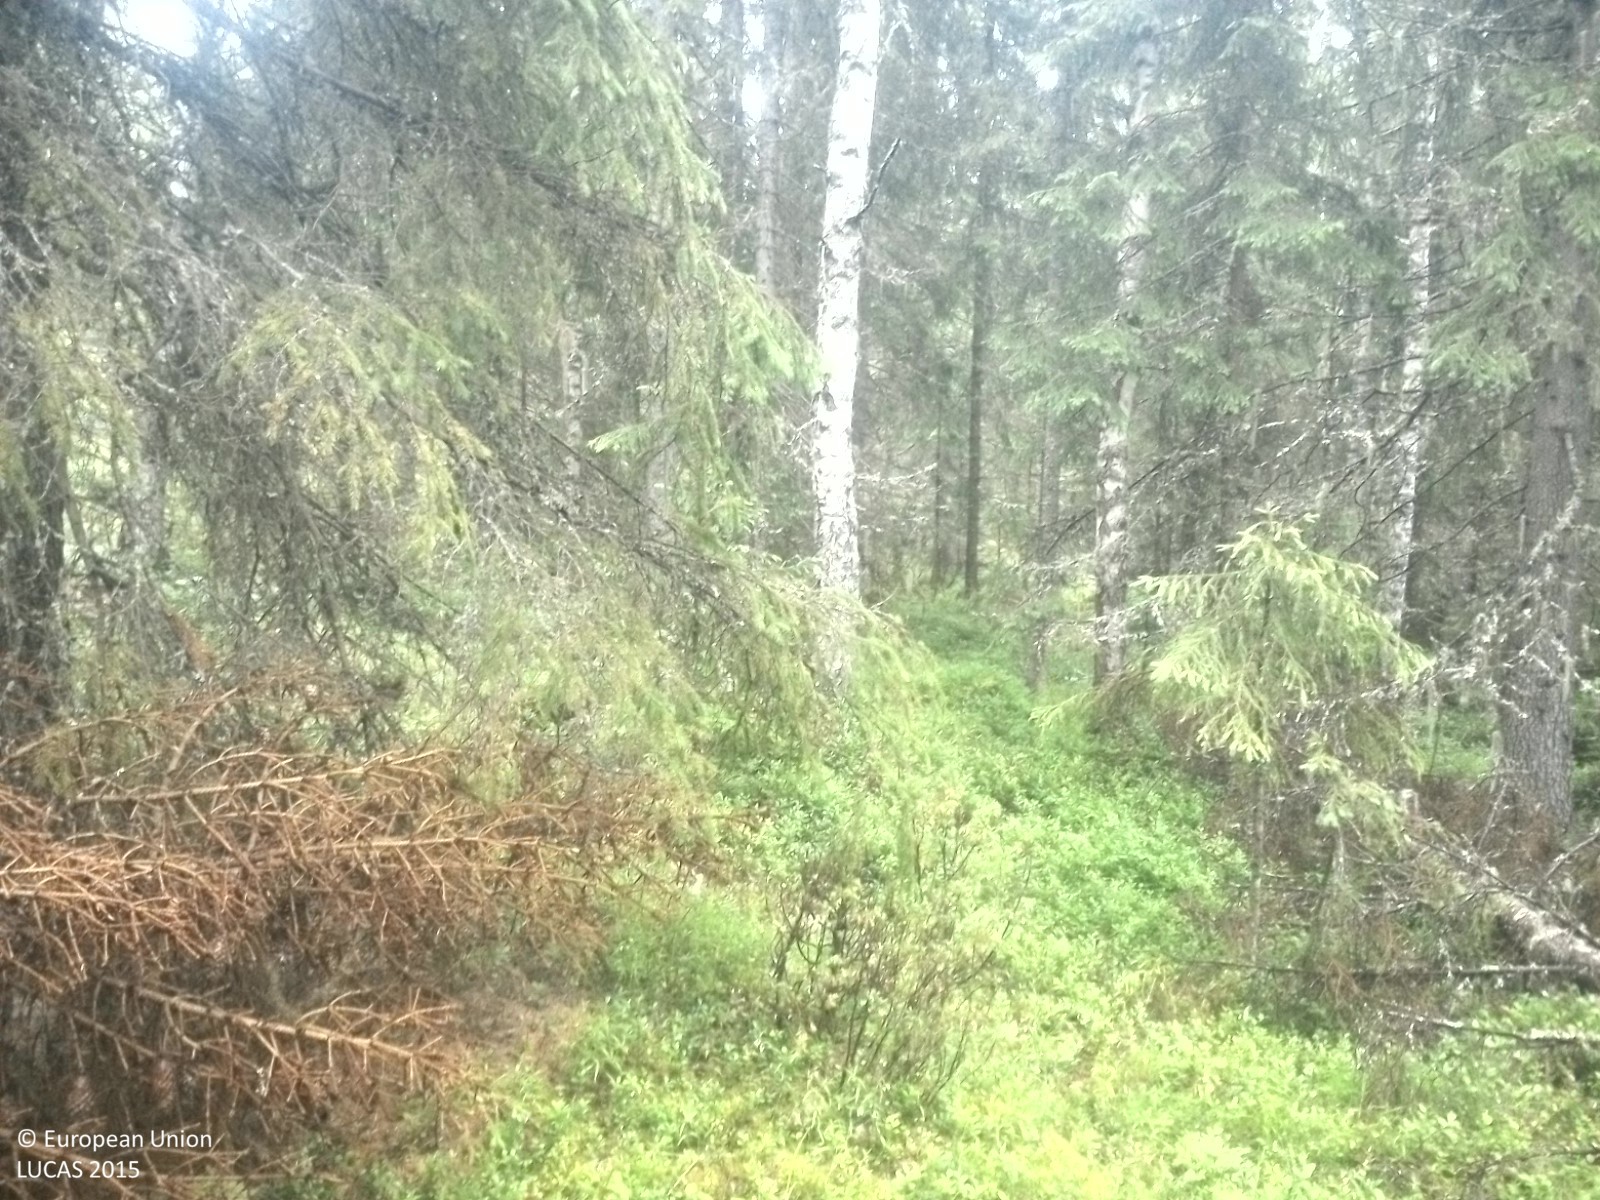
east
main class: Woodland
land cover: Spruce dominated mixed woodland
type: boreal forest
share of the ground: 50 - 75 %
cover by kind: coniferous forest trees 45 %, broadleaved forest trees 25 %, shrubs 15 %, lichens and mosses 15 %
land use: Forestry
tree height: > 5 m
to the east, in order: Spruce dominated mixed woodland; Spruce dominated coniferous woodland; Other mixed woodland; Spruce dominated mixed woodland; Spontaneously vegetated surfaces
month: July
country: SE
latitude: 62.4309
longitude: 17.0104
